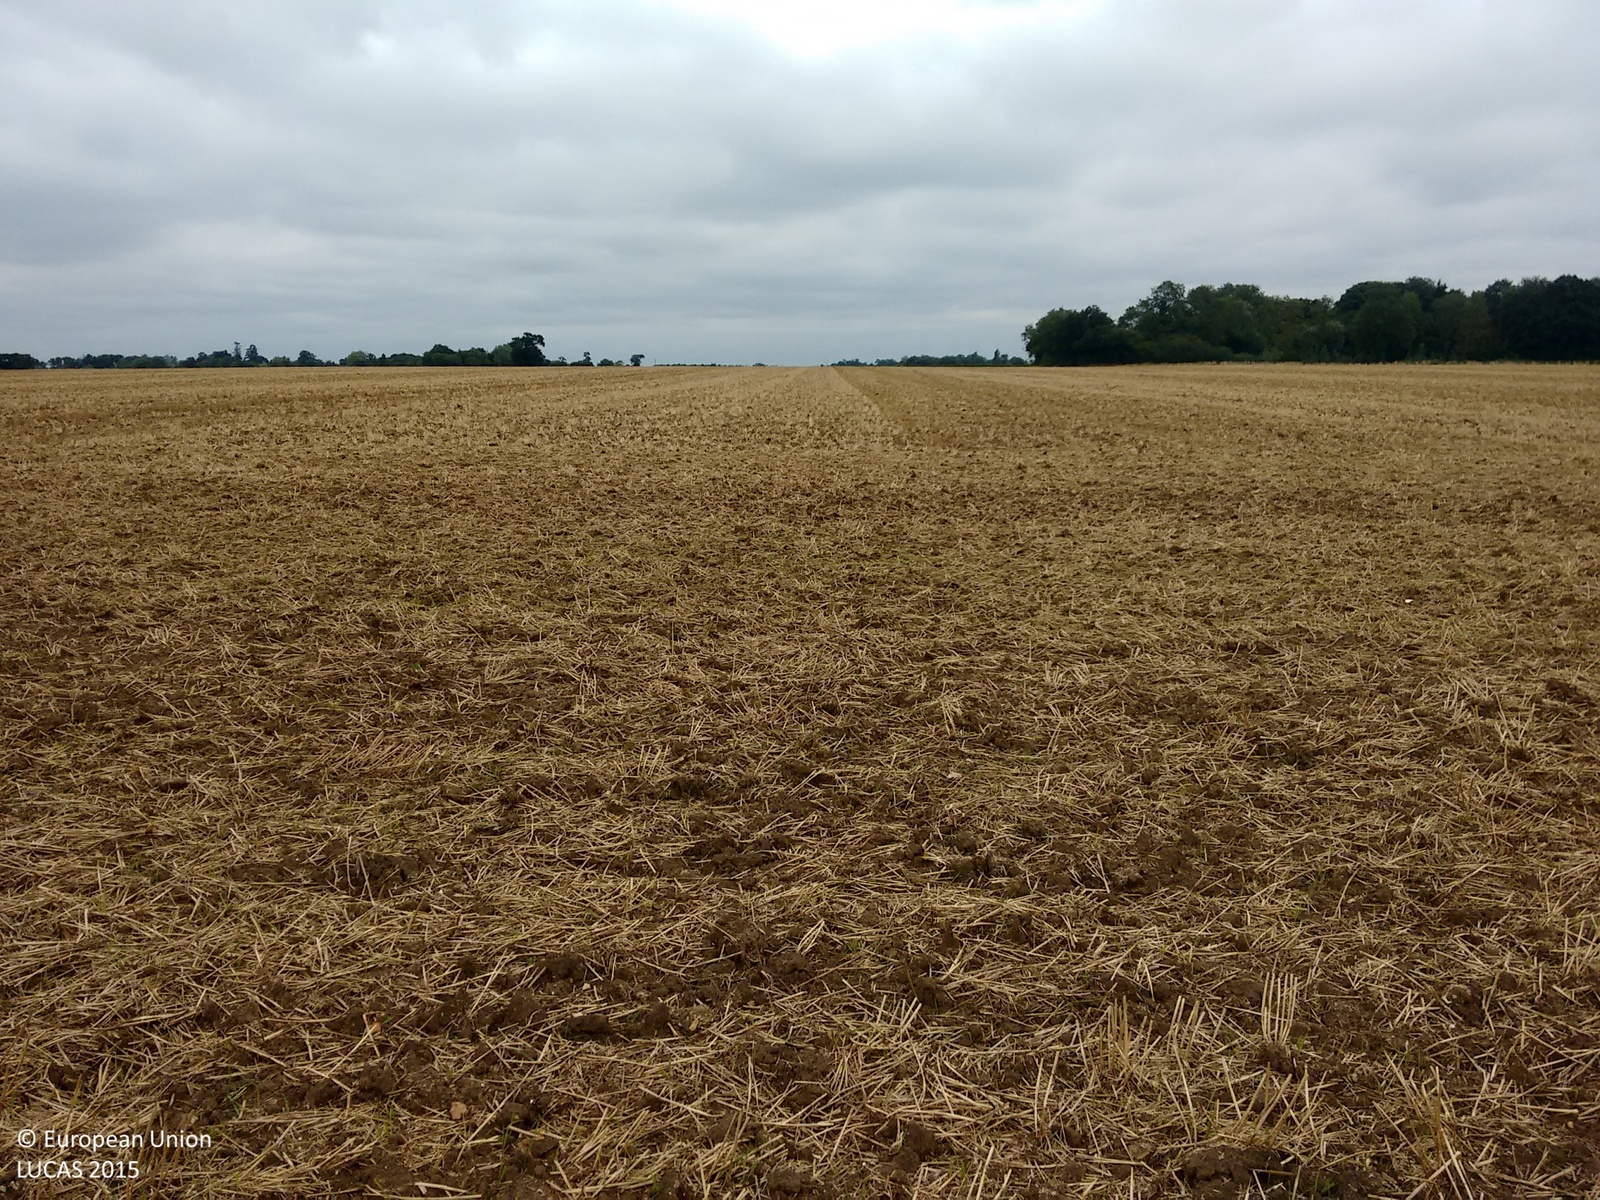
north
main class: Cropland
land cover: Common wheat
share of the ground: > 75 %
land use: Agriculture (excluding fallow land and kitchen gardens)
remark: Harvested field
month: September
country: GB
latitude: 52.2653
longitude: 0.9355
